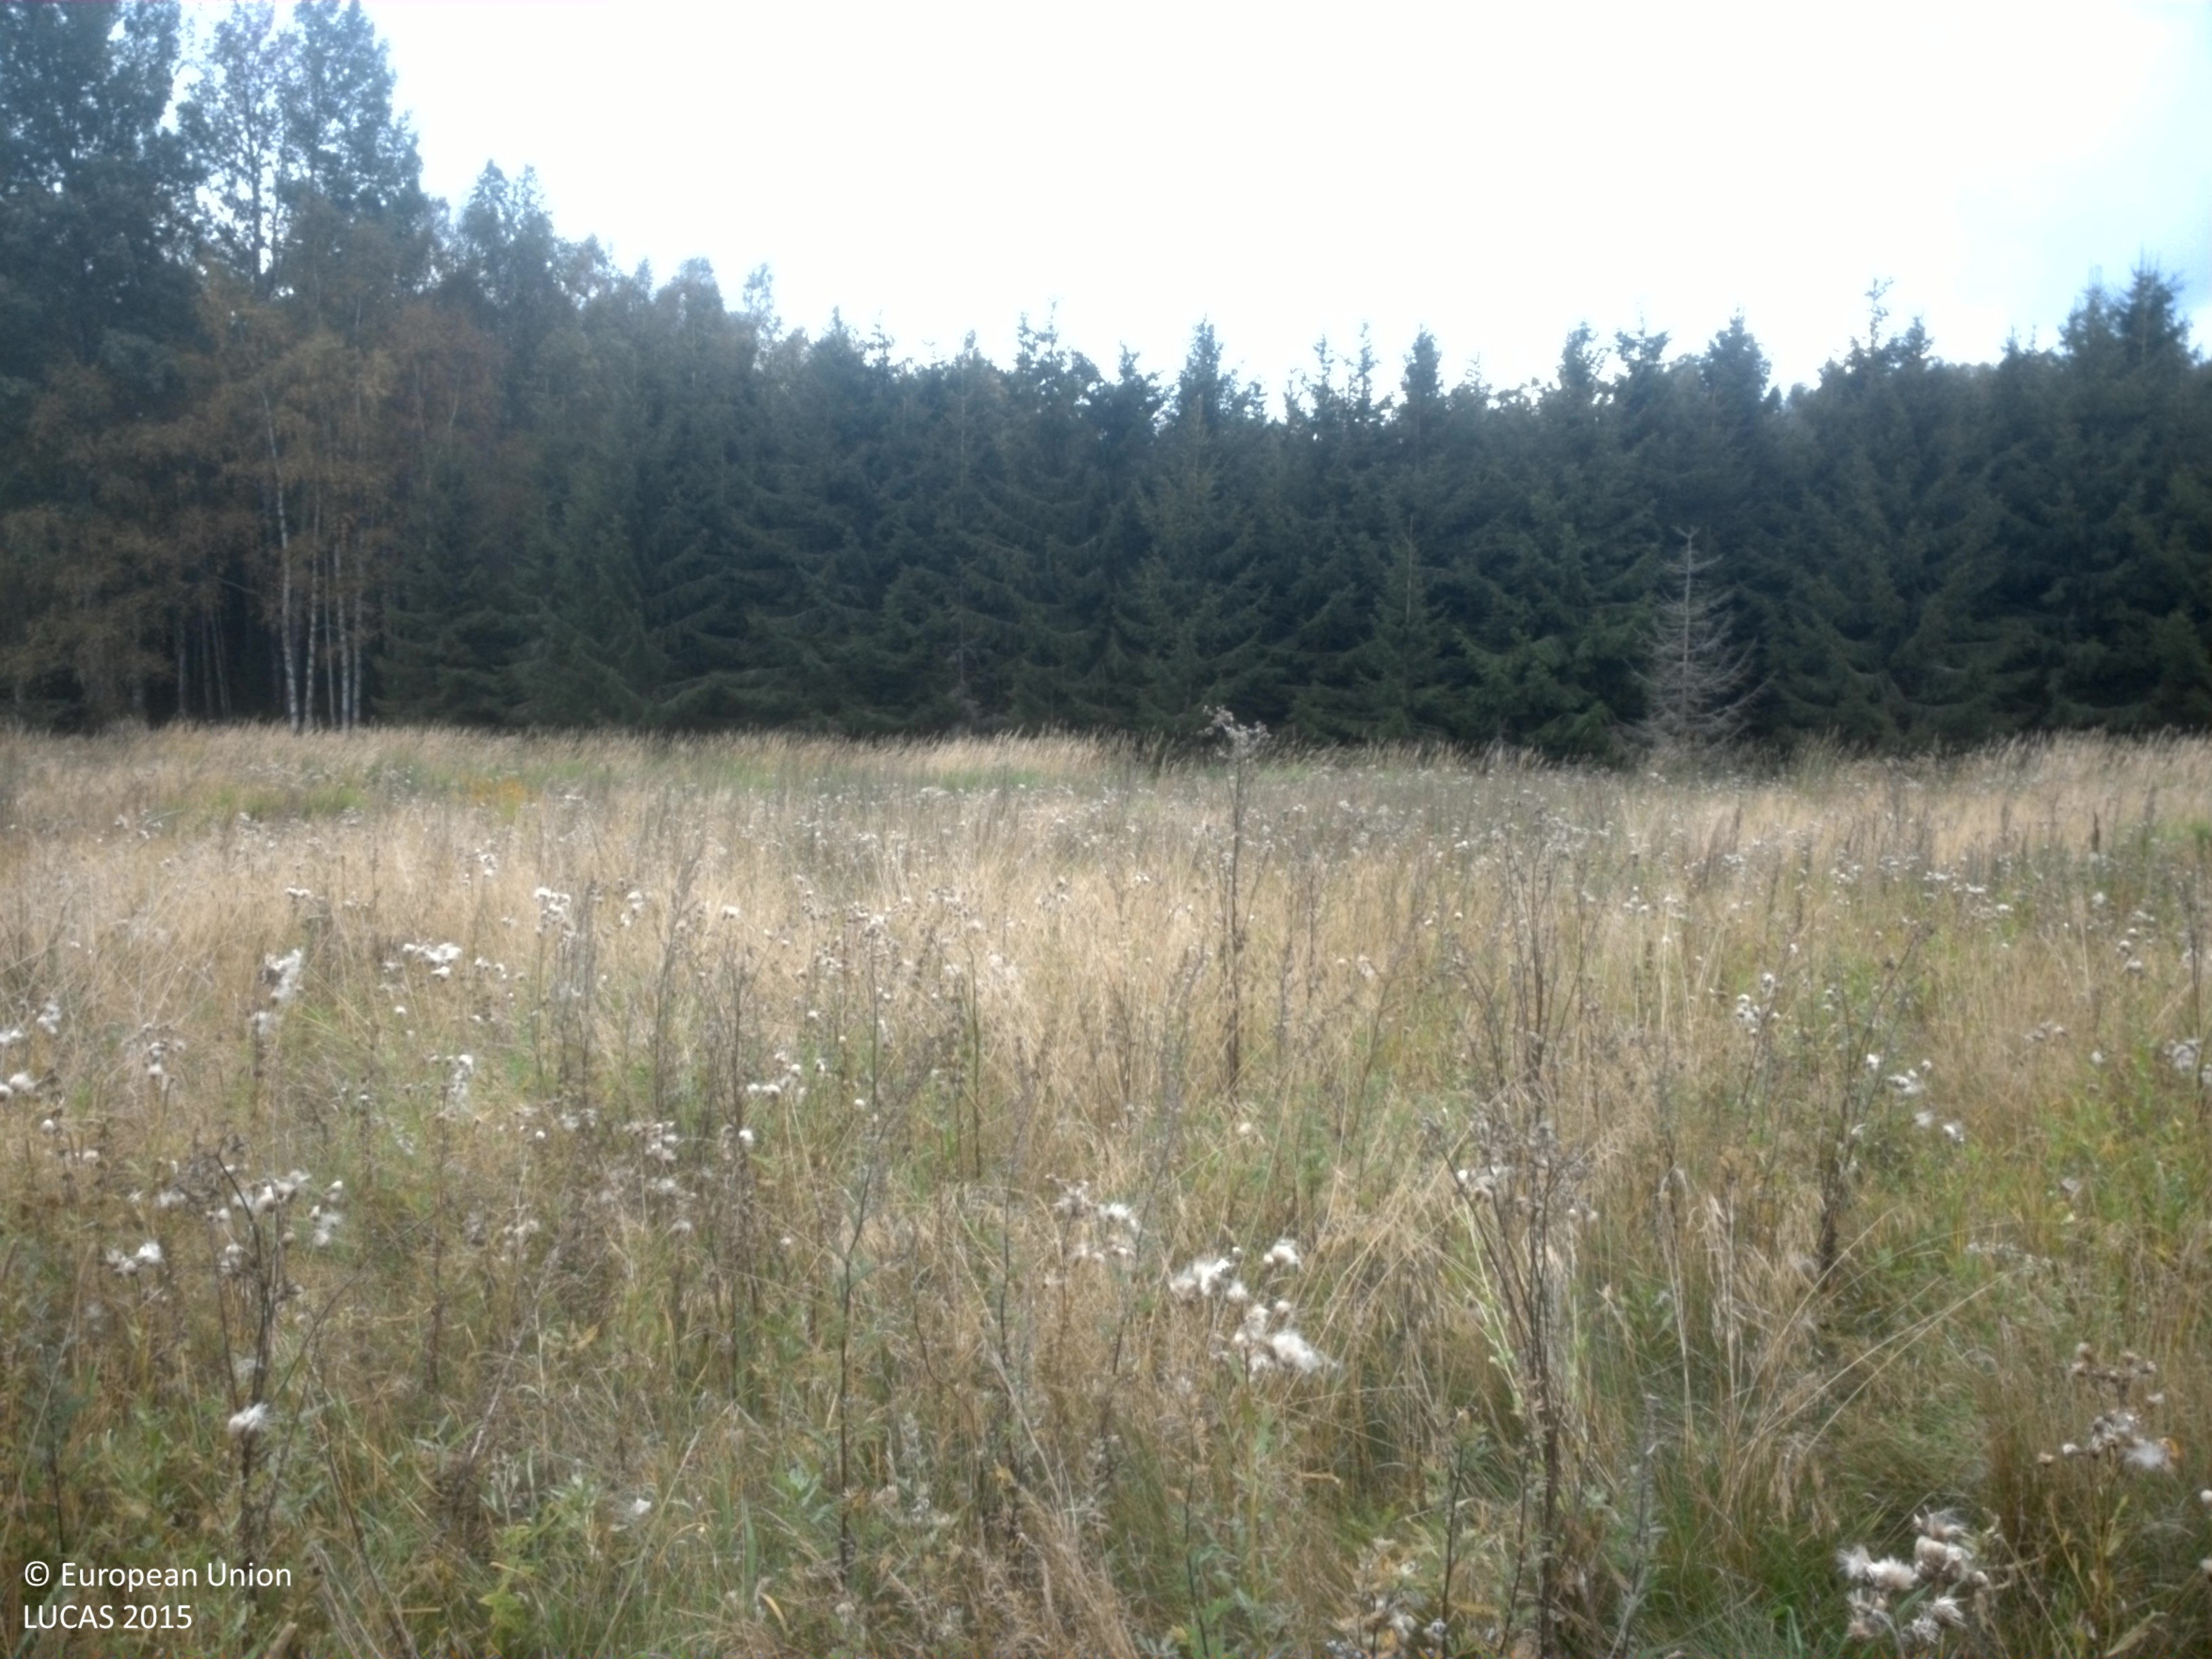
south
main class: Grassland
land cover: Spontaneously vegetated surfaces
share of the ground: > 75 %
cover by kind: herbaceous plants 100 %
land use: Agriculture (excluding fallow land and kitchen gardens)
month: September
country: SE
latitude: 59.5697
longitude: 15.4604
